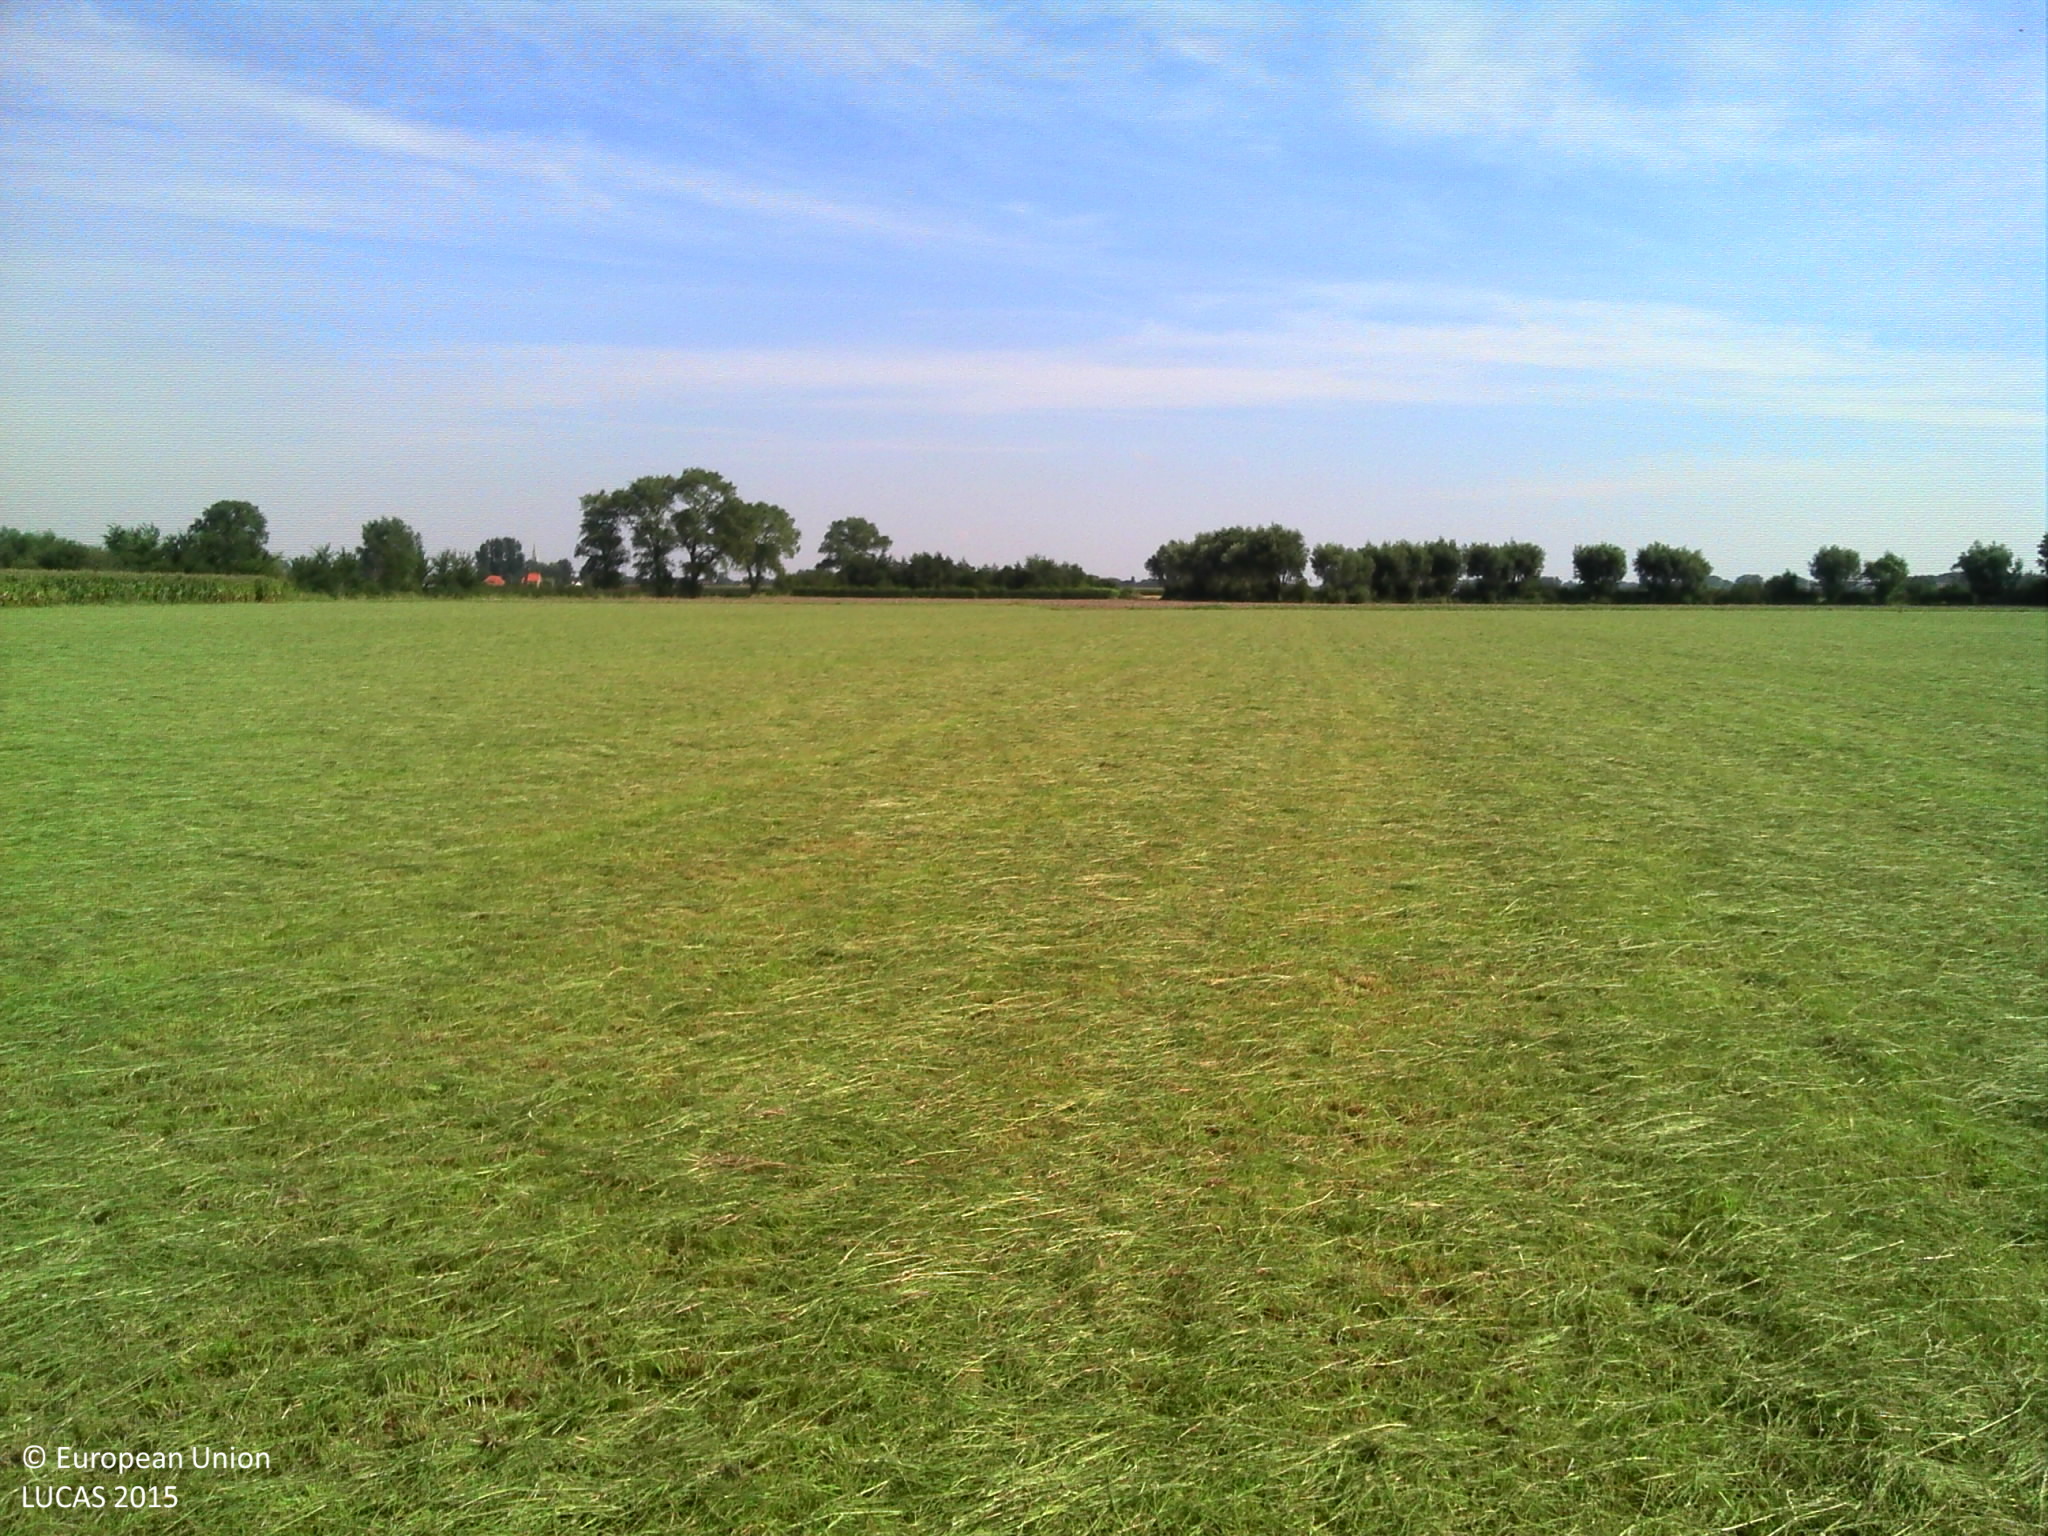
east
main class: Grassland
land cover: Grassland without tree/shrub cover
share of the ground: > 75 %
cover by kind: herbaceous plants 100 %
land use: Agriculture (excluding fallow land and kitchen gardens)
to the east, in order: Grassland without tree/shrub cover; Common wheat
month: September
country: BE
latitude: 51.1762
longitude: 2.9664
